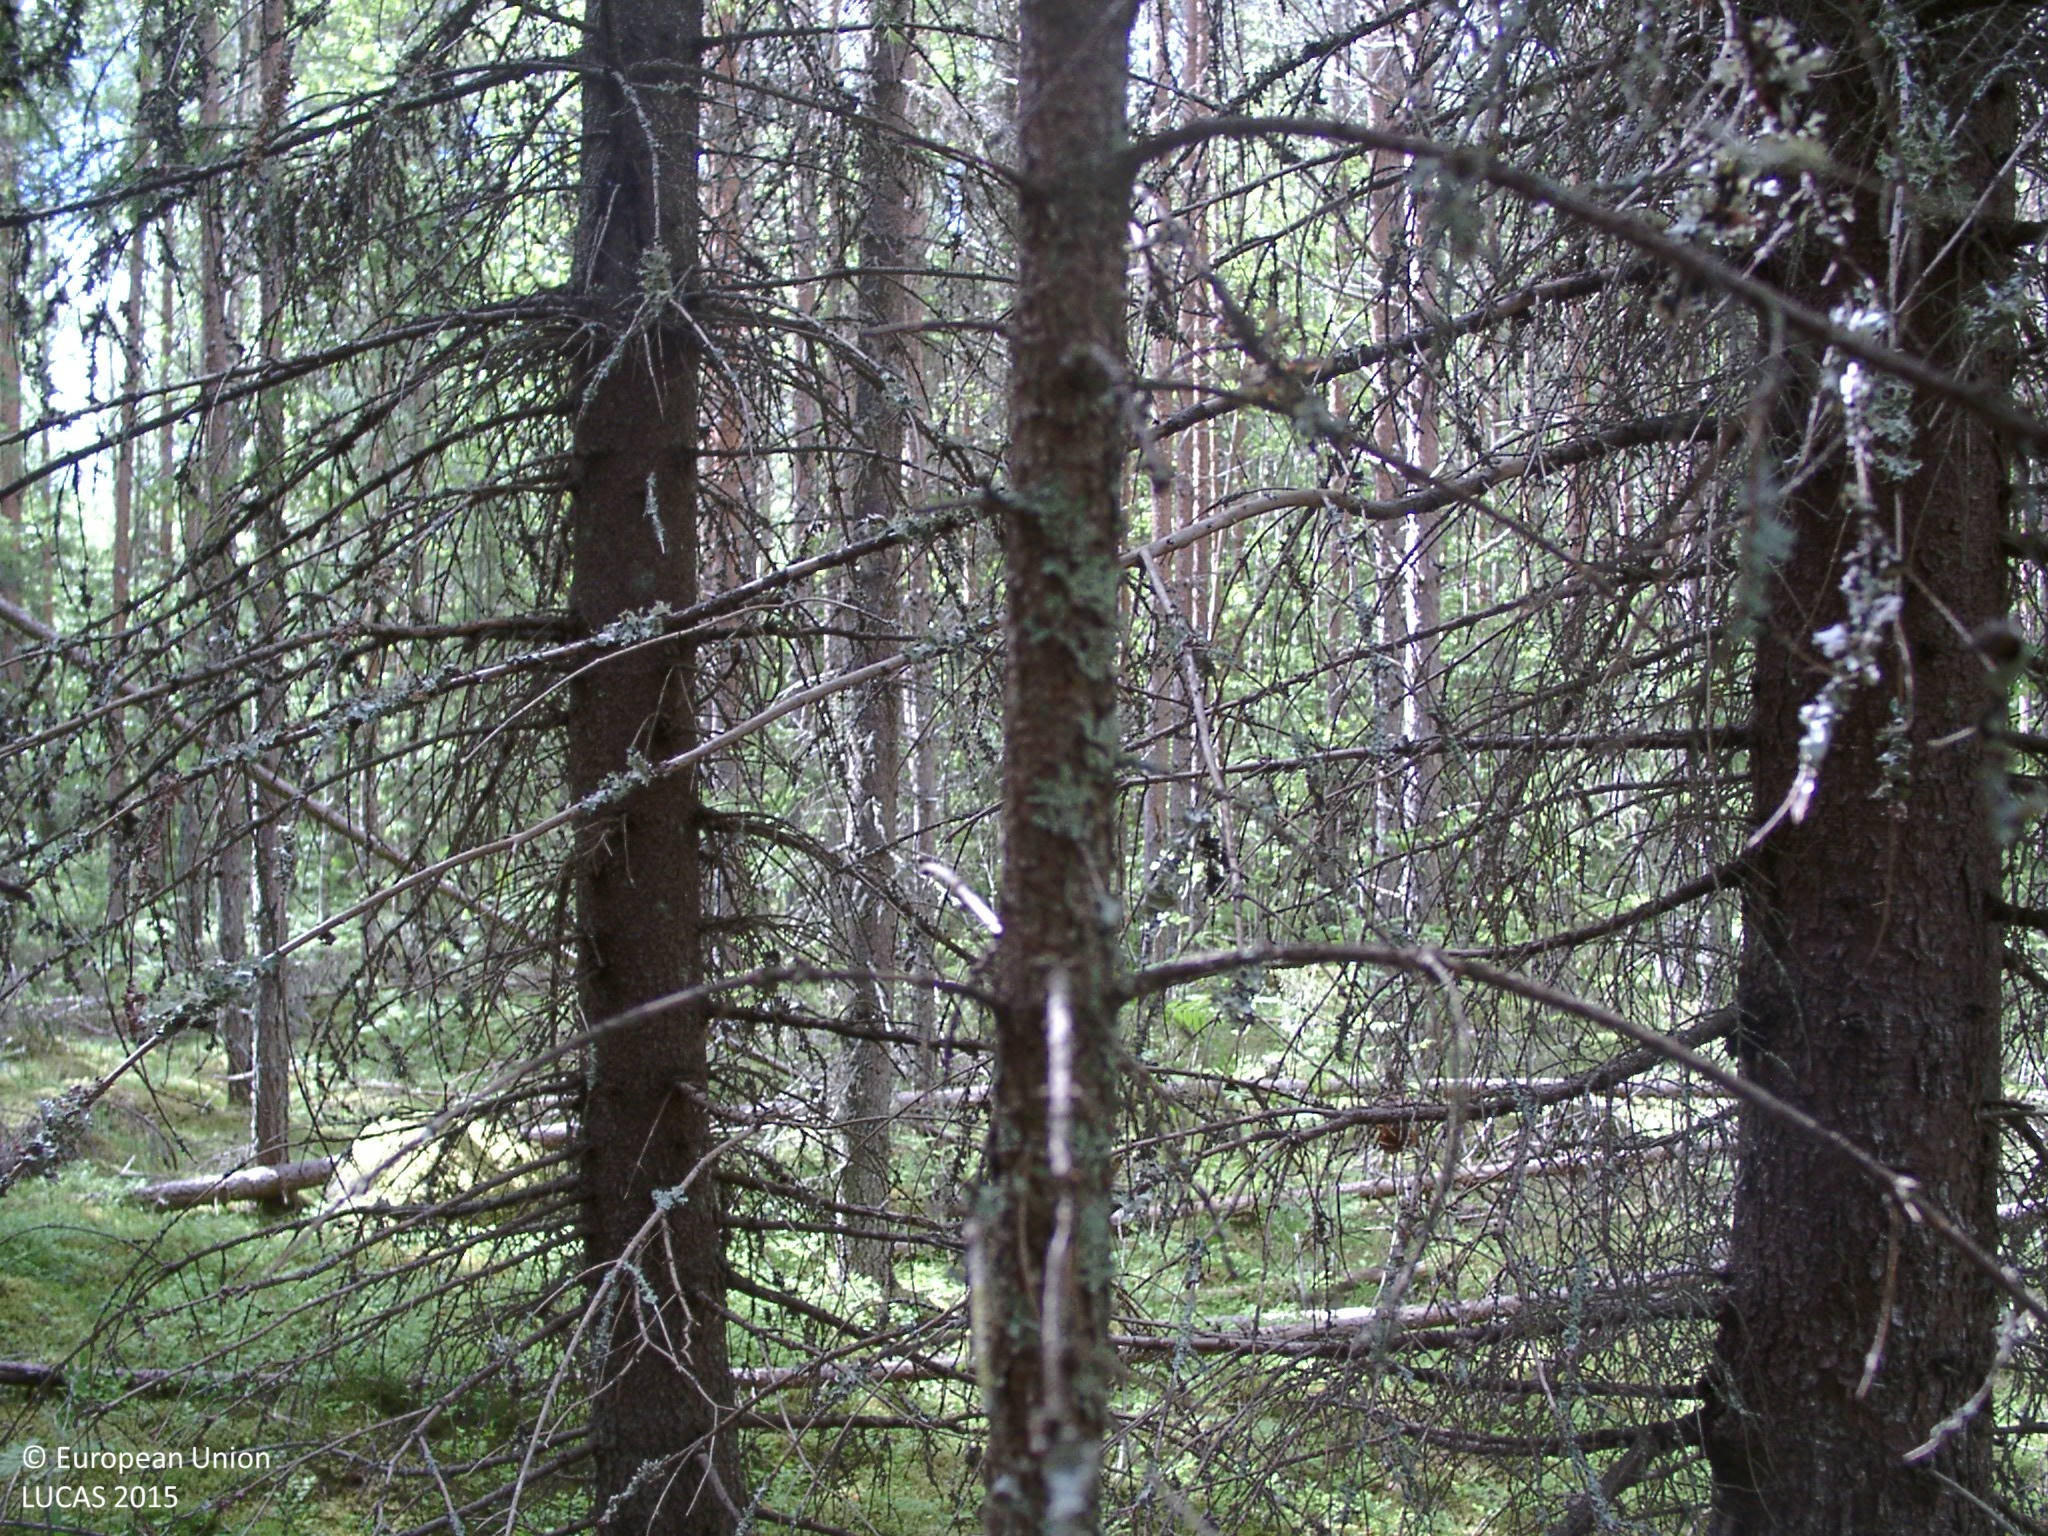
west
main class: Woodland
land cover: Spruce dominated coniferous woodland
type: boreal forest
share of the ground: > 75 %
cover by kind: coniferous forest trees 75 %, lichens and mosses 20 %, shrubs 5 %
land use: Semi-natural and natural areas not in use
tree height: > 5 m
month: June
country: FI
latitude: 61.8447
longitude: 24.5536
